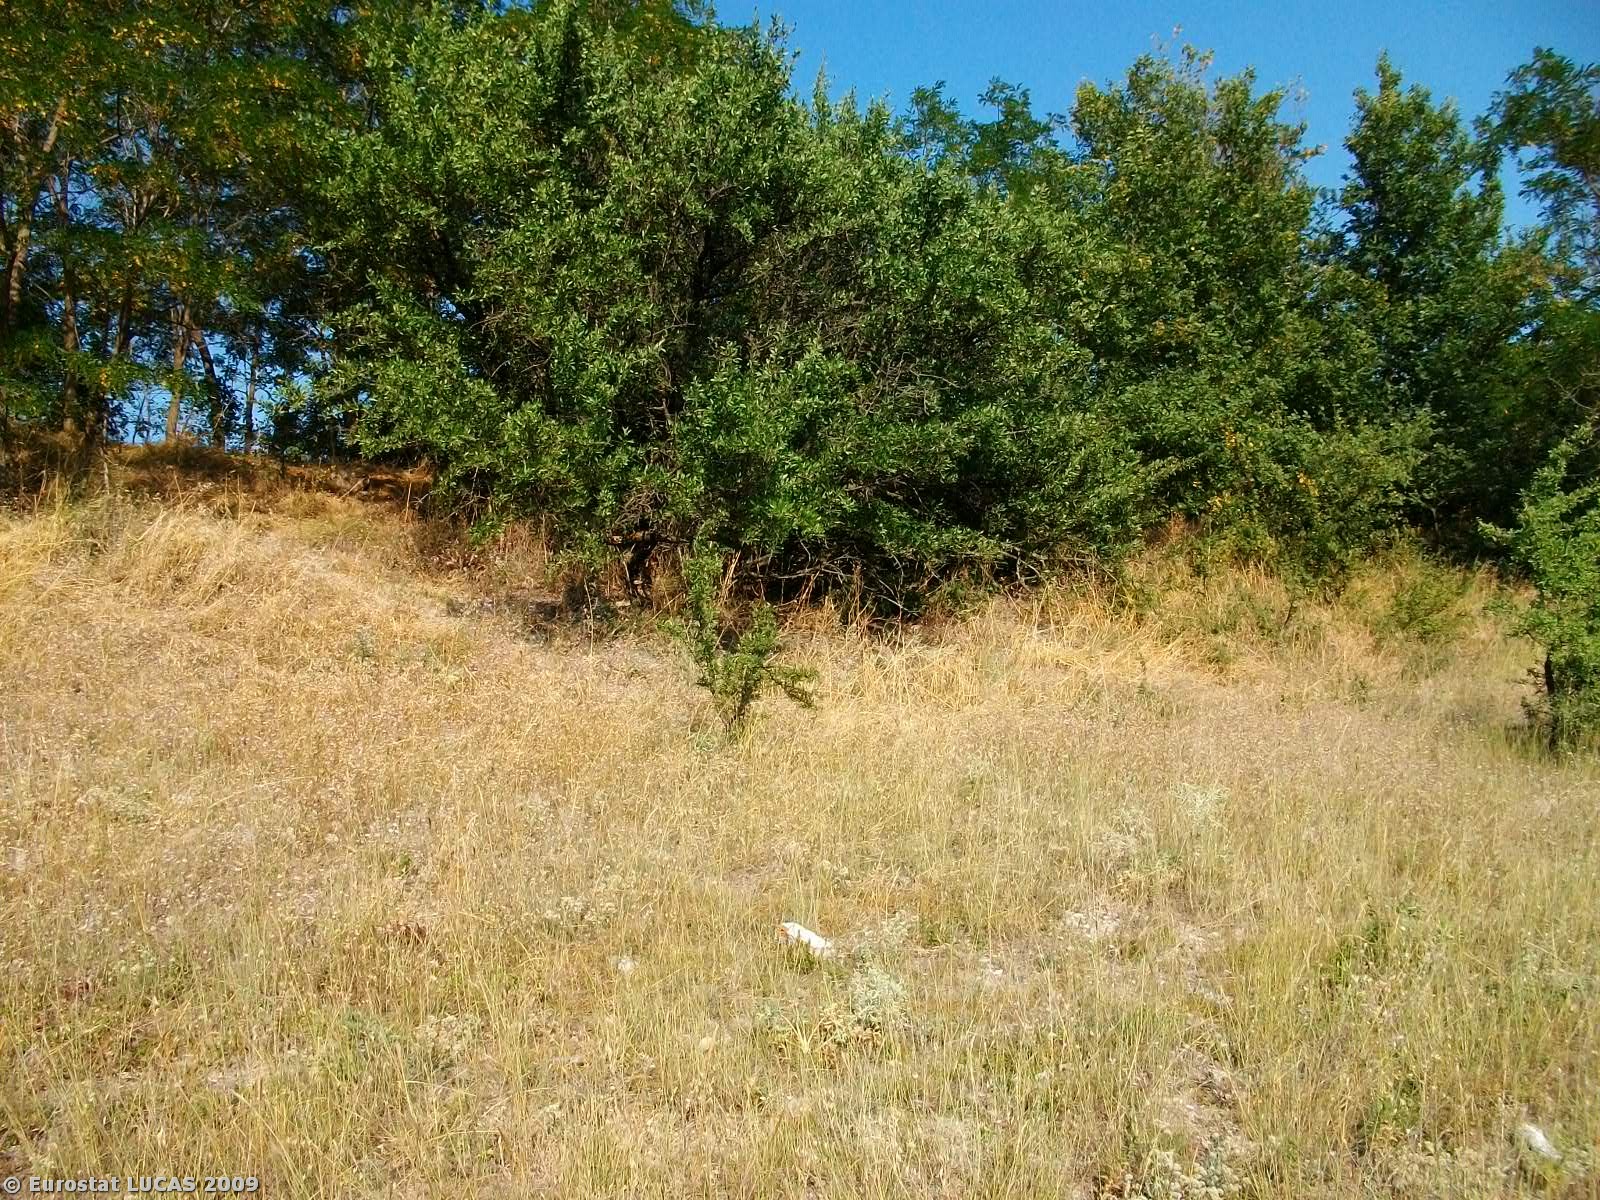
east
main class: Grassland
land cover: Grassland with sparse tree/shrub cover
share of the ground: > 75 %
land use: Unused
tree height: > 5 m
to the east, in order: Grassland with sparse tree/shrub cover; Broadleaved woodland; Paved roads, cycling and walking lanes; Broadleaved woodland; Durum wheat; Electric lines; Durum wheat; Vineyards; Paved roads, cycling and walking lanes; Grass margins; Durum wheat
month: July
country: GR
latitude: 40.2431
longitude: 21.8289
